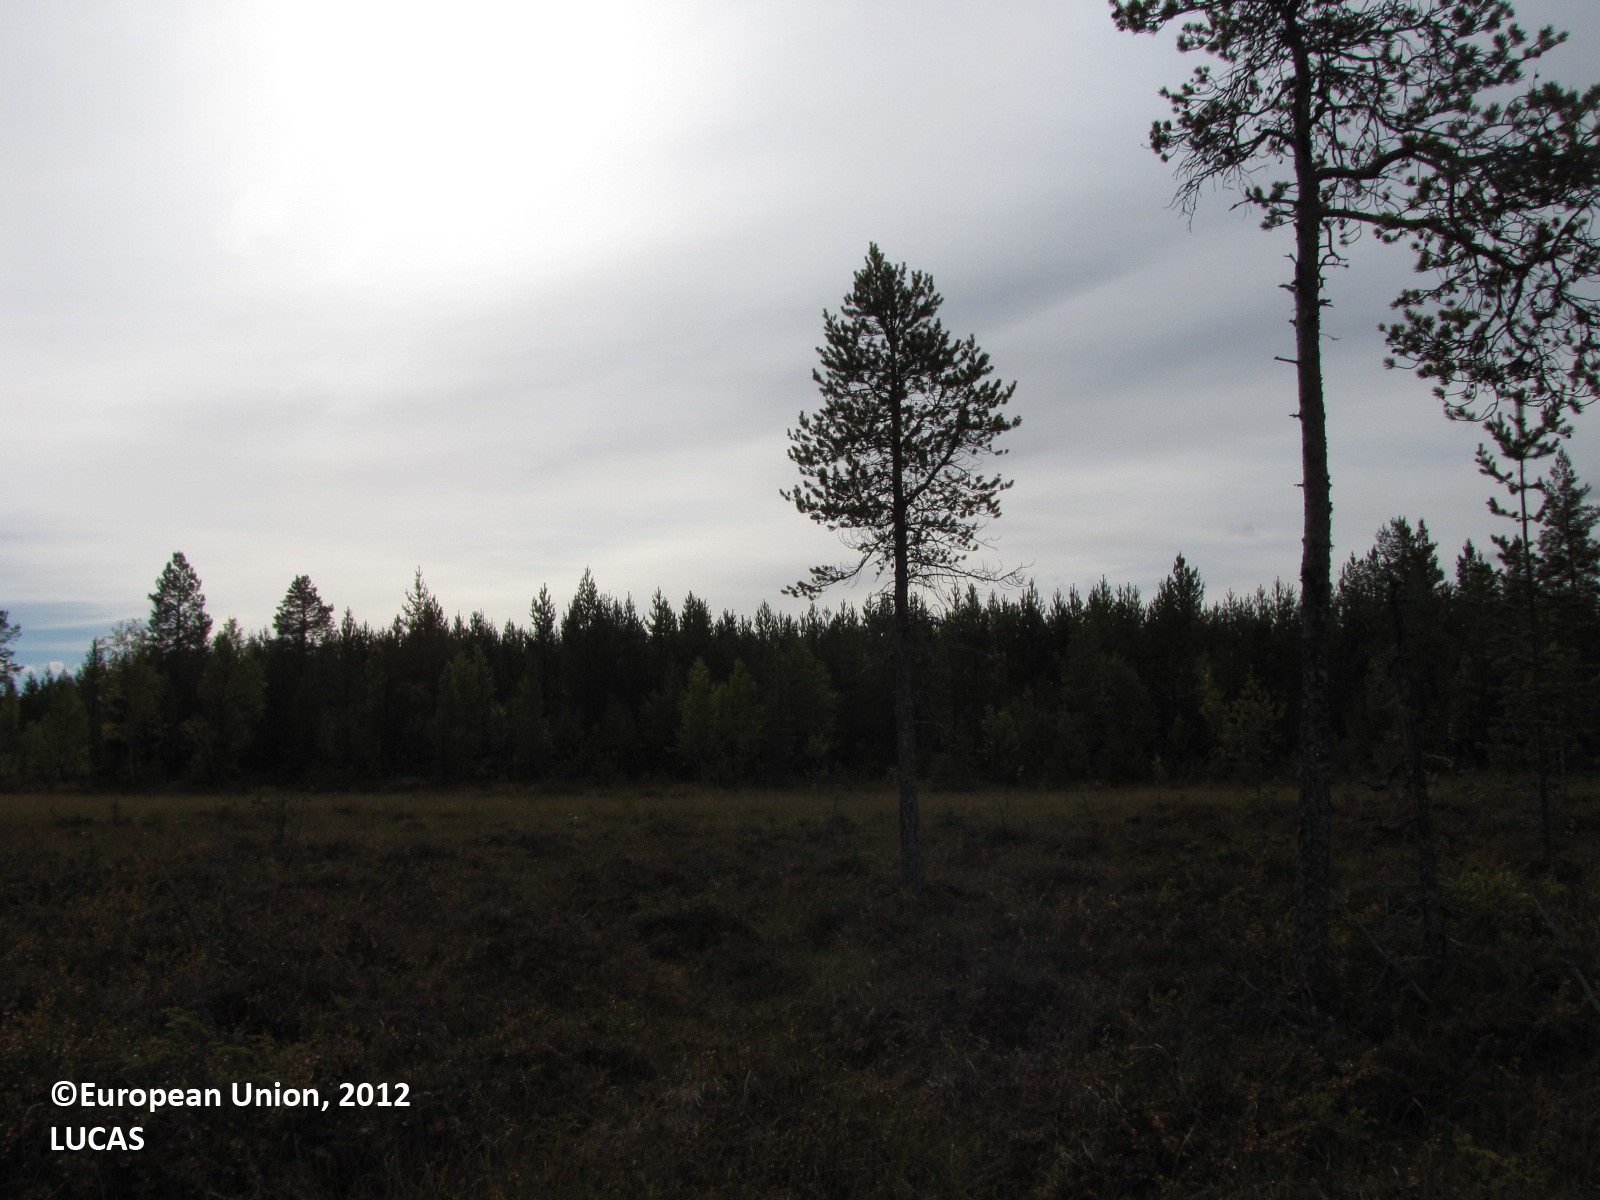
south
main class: Woodland
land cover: Pine dominated coniferous woodland
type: boreal forest
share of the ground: 10 - 25 %
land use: Forestry
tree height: < 5 m
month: September
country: FI
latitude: 67.1478
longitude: 24.8794
